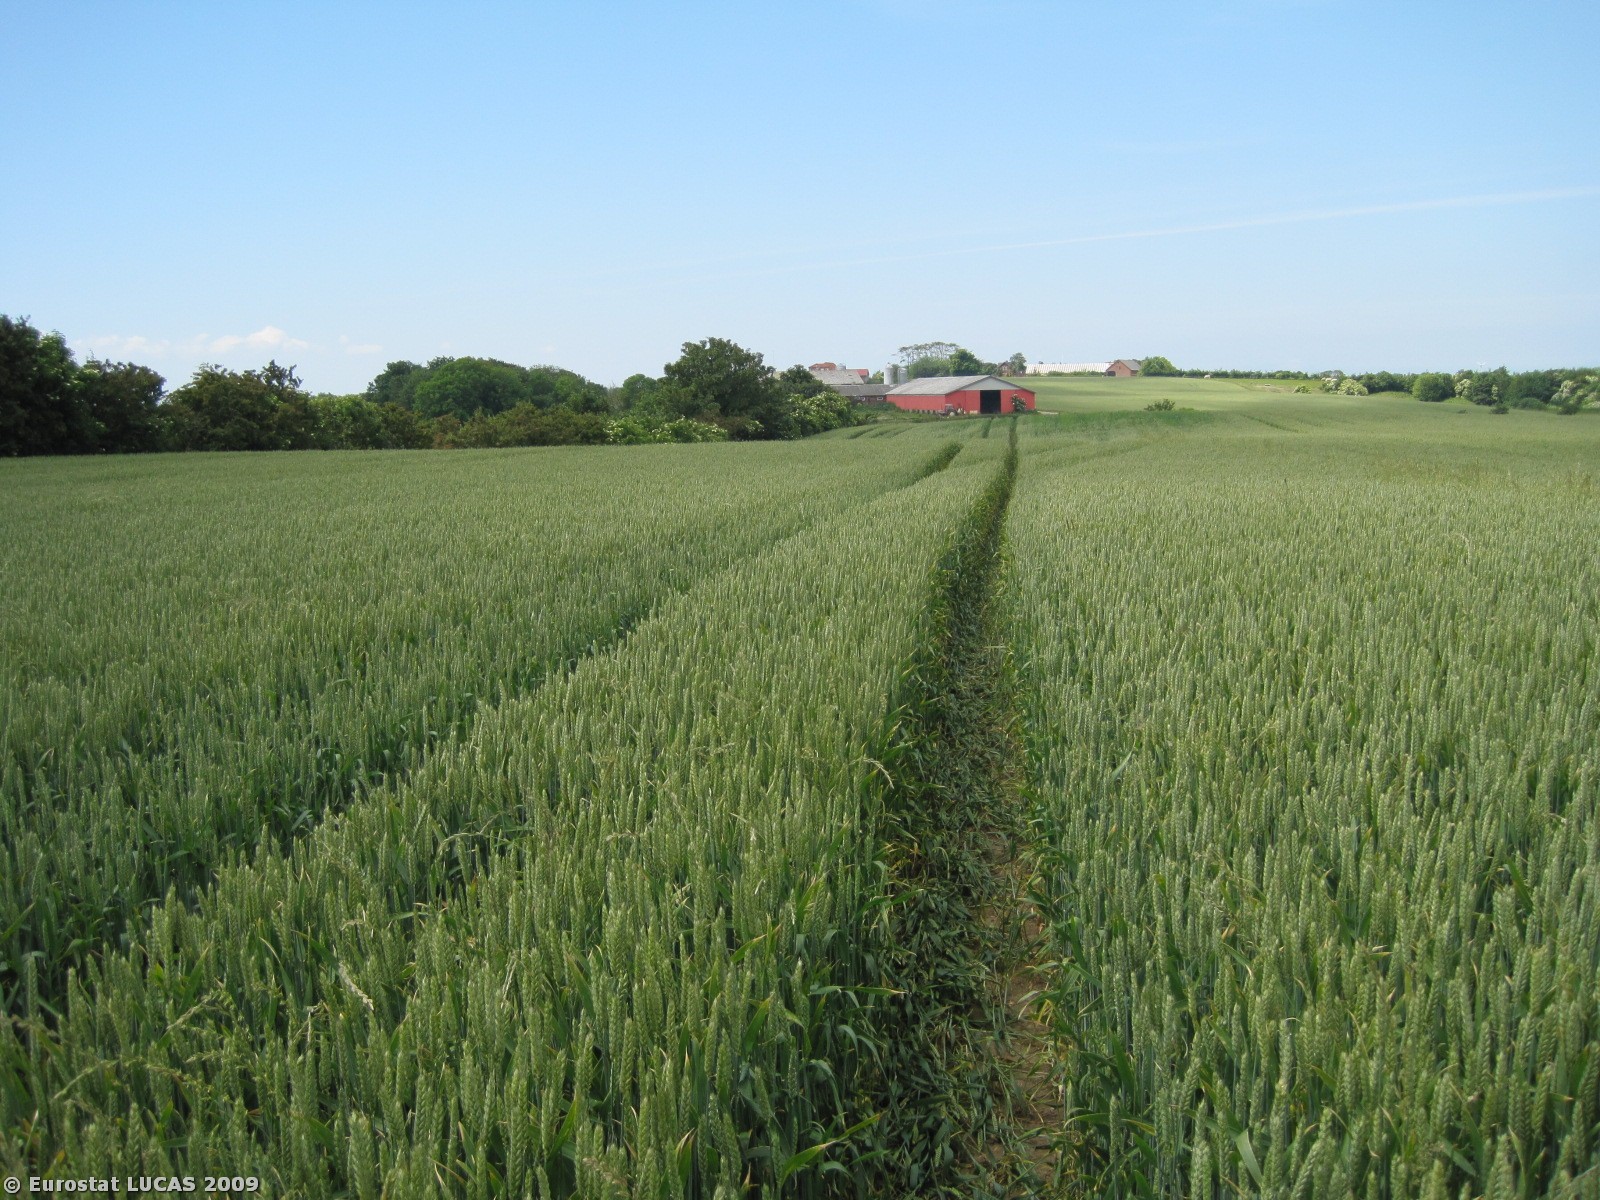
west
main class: Cropland
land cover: Common wheat
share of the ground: > 75 %
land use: Agriculture (excluding fallow land and kitchen gardens)
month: June
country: DK
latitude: 56.5775
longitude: 8.7807
